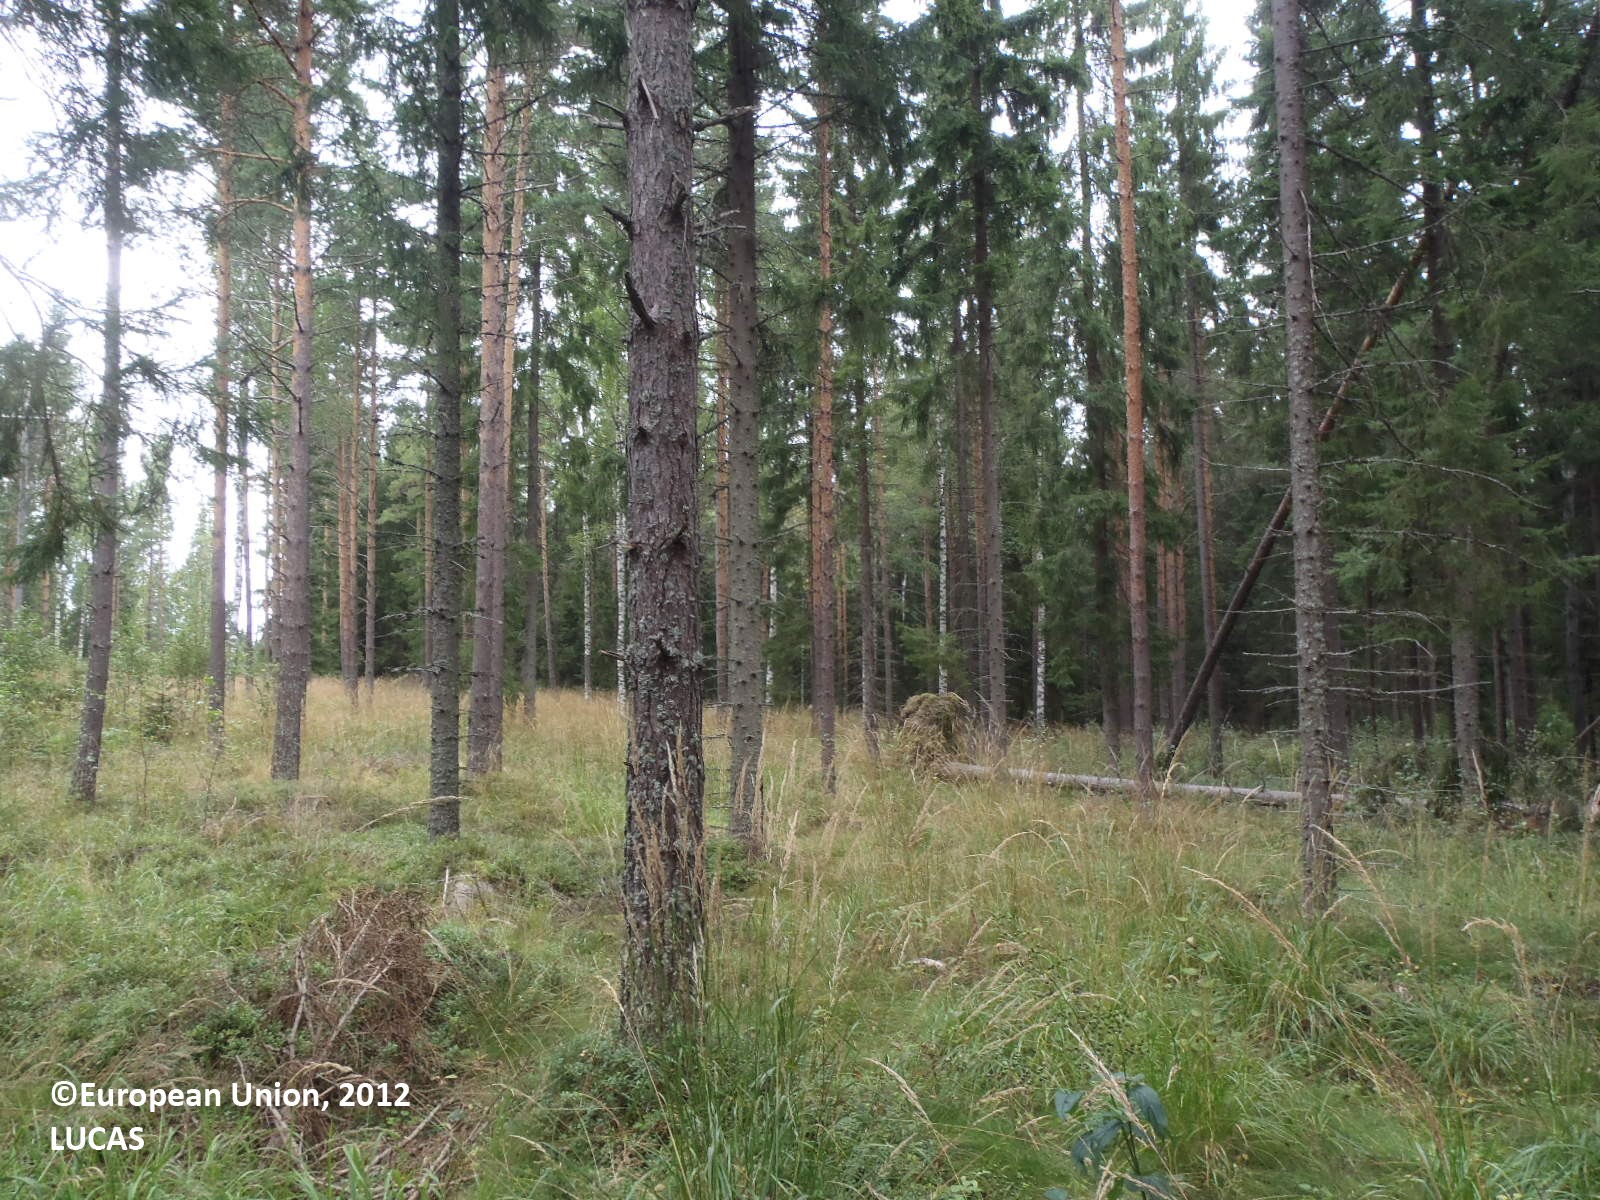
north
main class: Woodland
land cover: Spruce dominated coniferous woodland
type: boreal forest
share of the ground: > 75 %
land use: Forestry
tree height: > 5 m
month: August
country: FI
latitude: 60.7146
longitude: 22.3269
